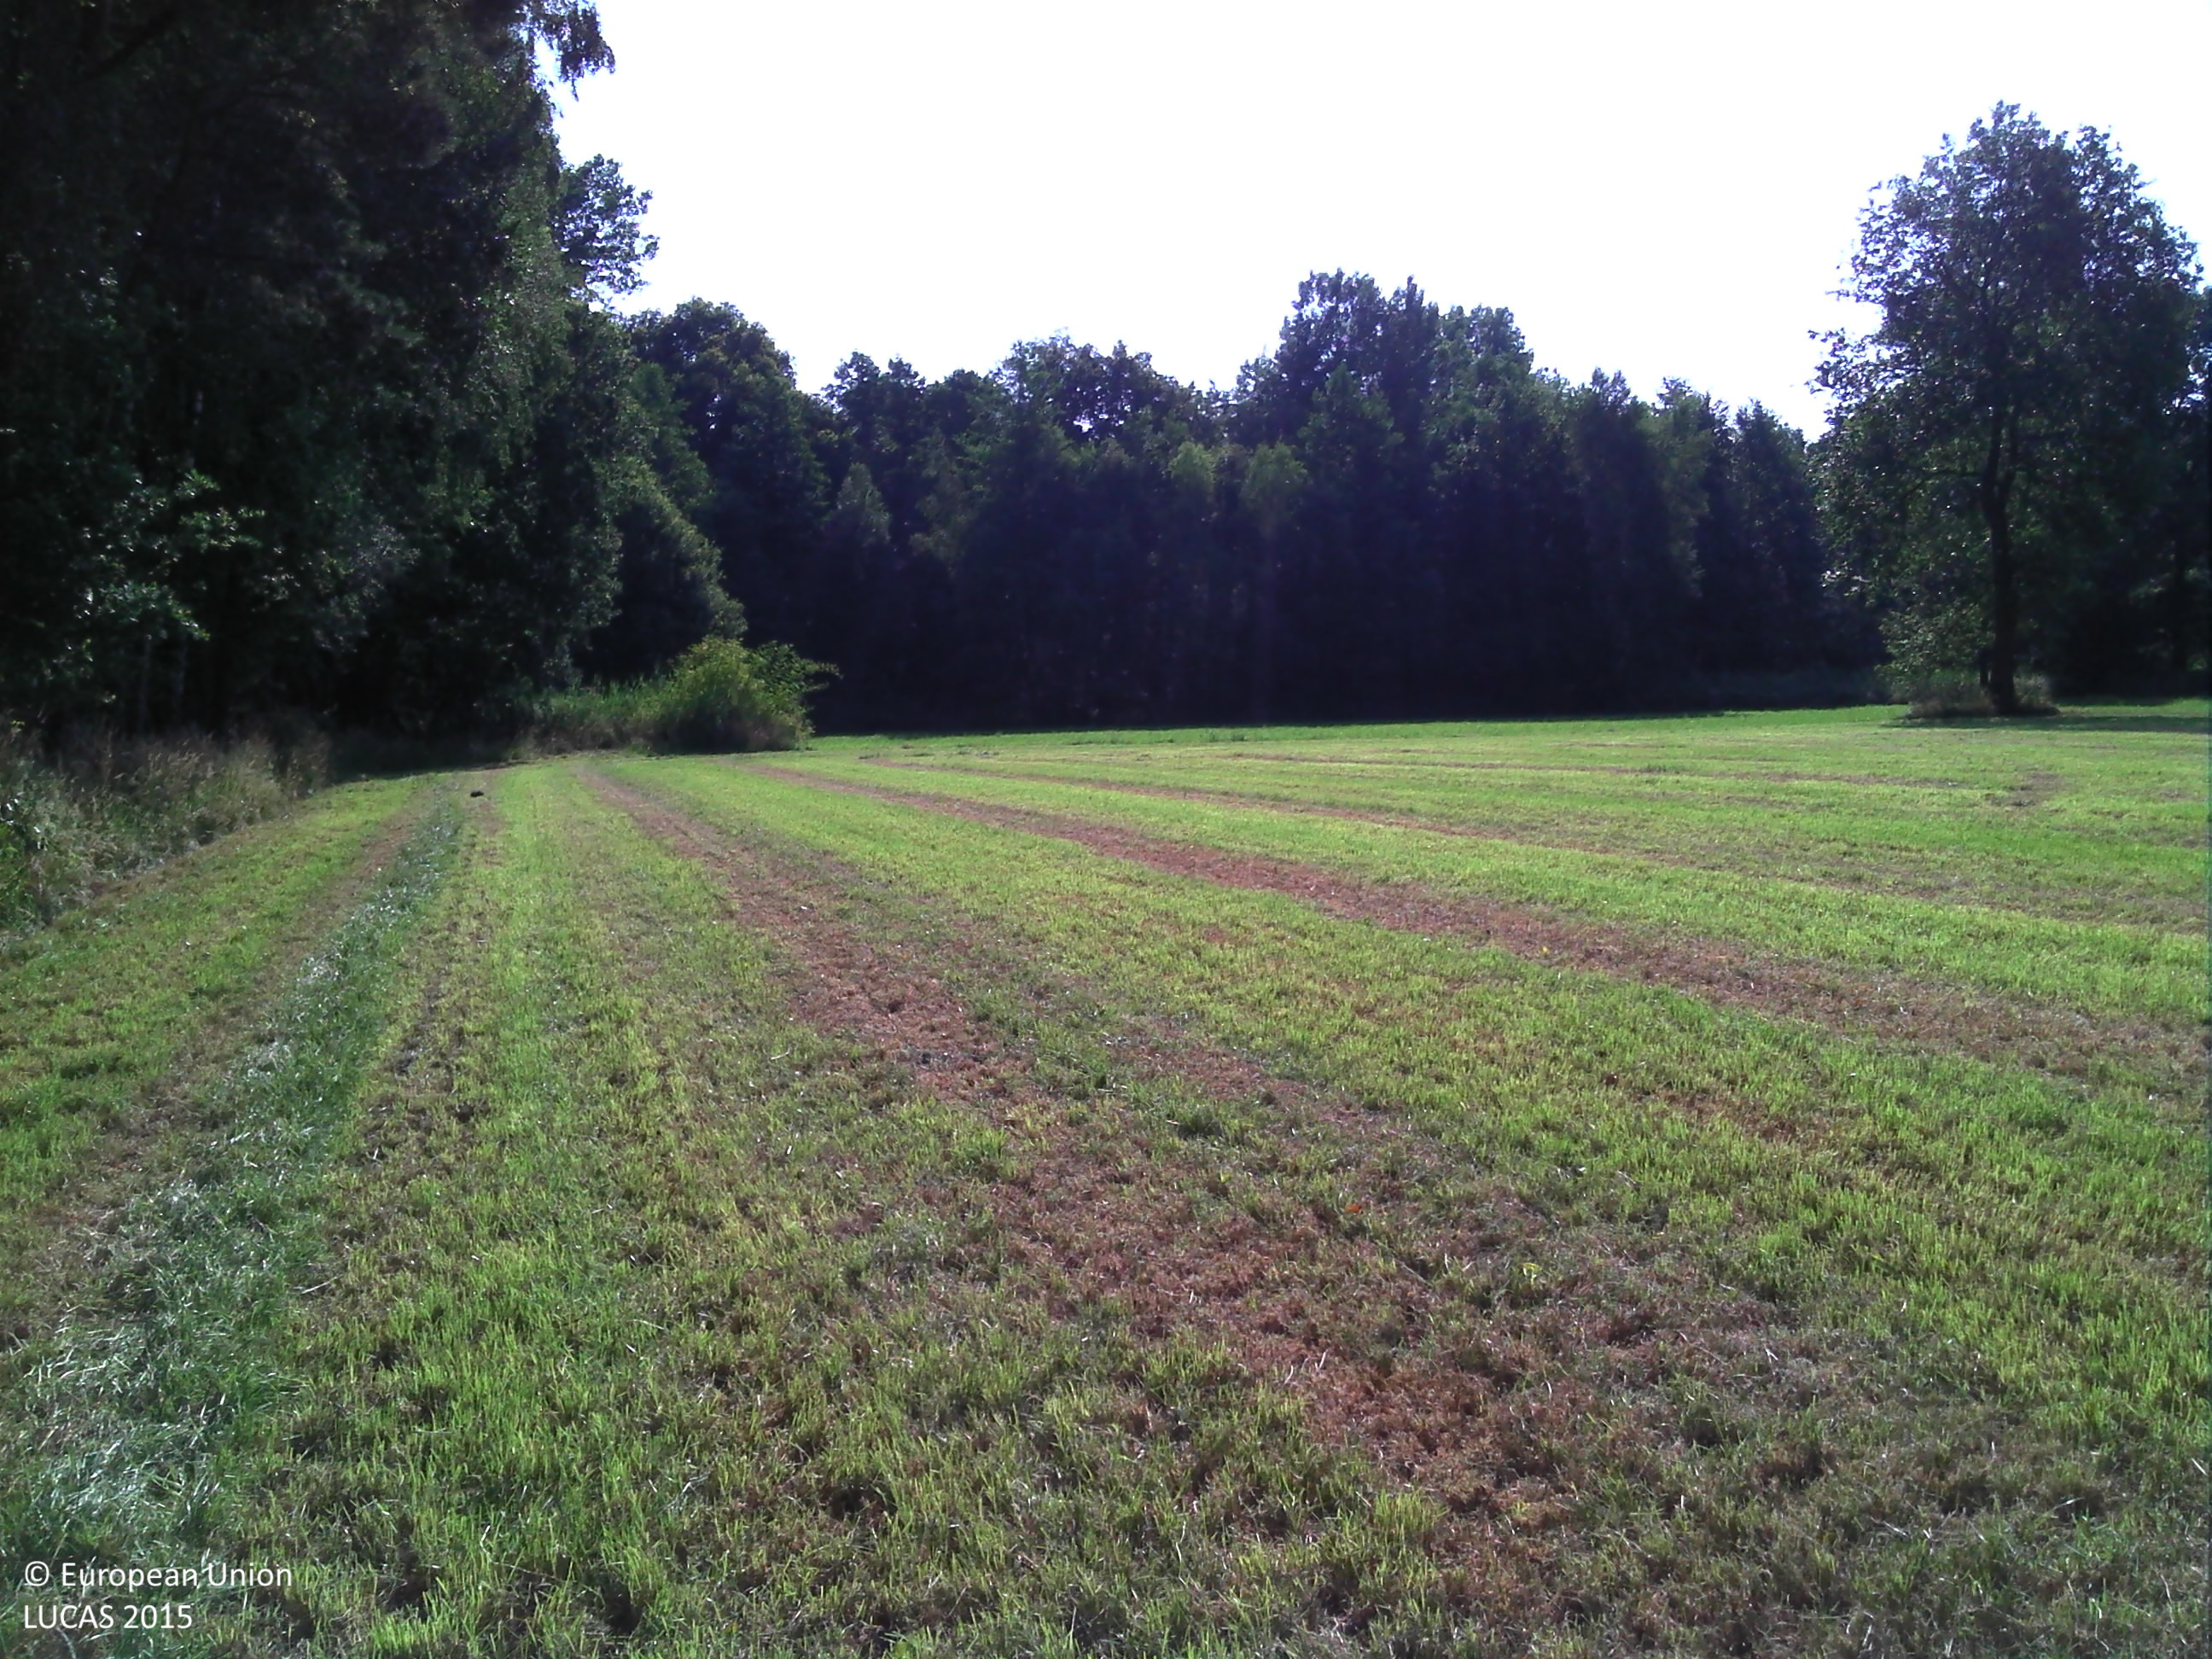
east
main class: Grassland
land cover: Grassland without tree/shrub cover
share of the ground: > 75 %
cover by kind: herbaceous plants 100 %
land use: Agriculture (excluding fallow land and kitchen gardens)
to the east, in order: Grassland without tree/shrub cover; Broadleaved woodland; Inland fresh water bodies; Broadleaved woodland; Rivers and streams; Broadleaved woodland; Grass margins; Paved roads, cycling and walking lanes
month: July
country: BE
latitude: 51.1039
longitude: 5.4994
